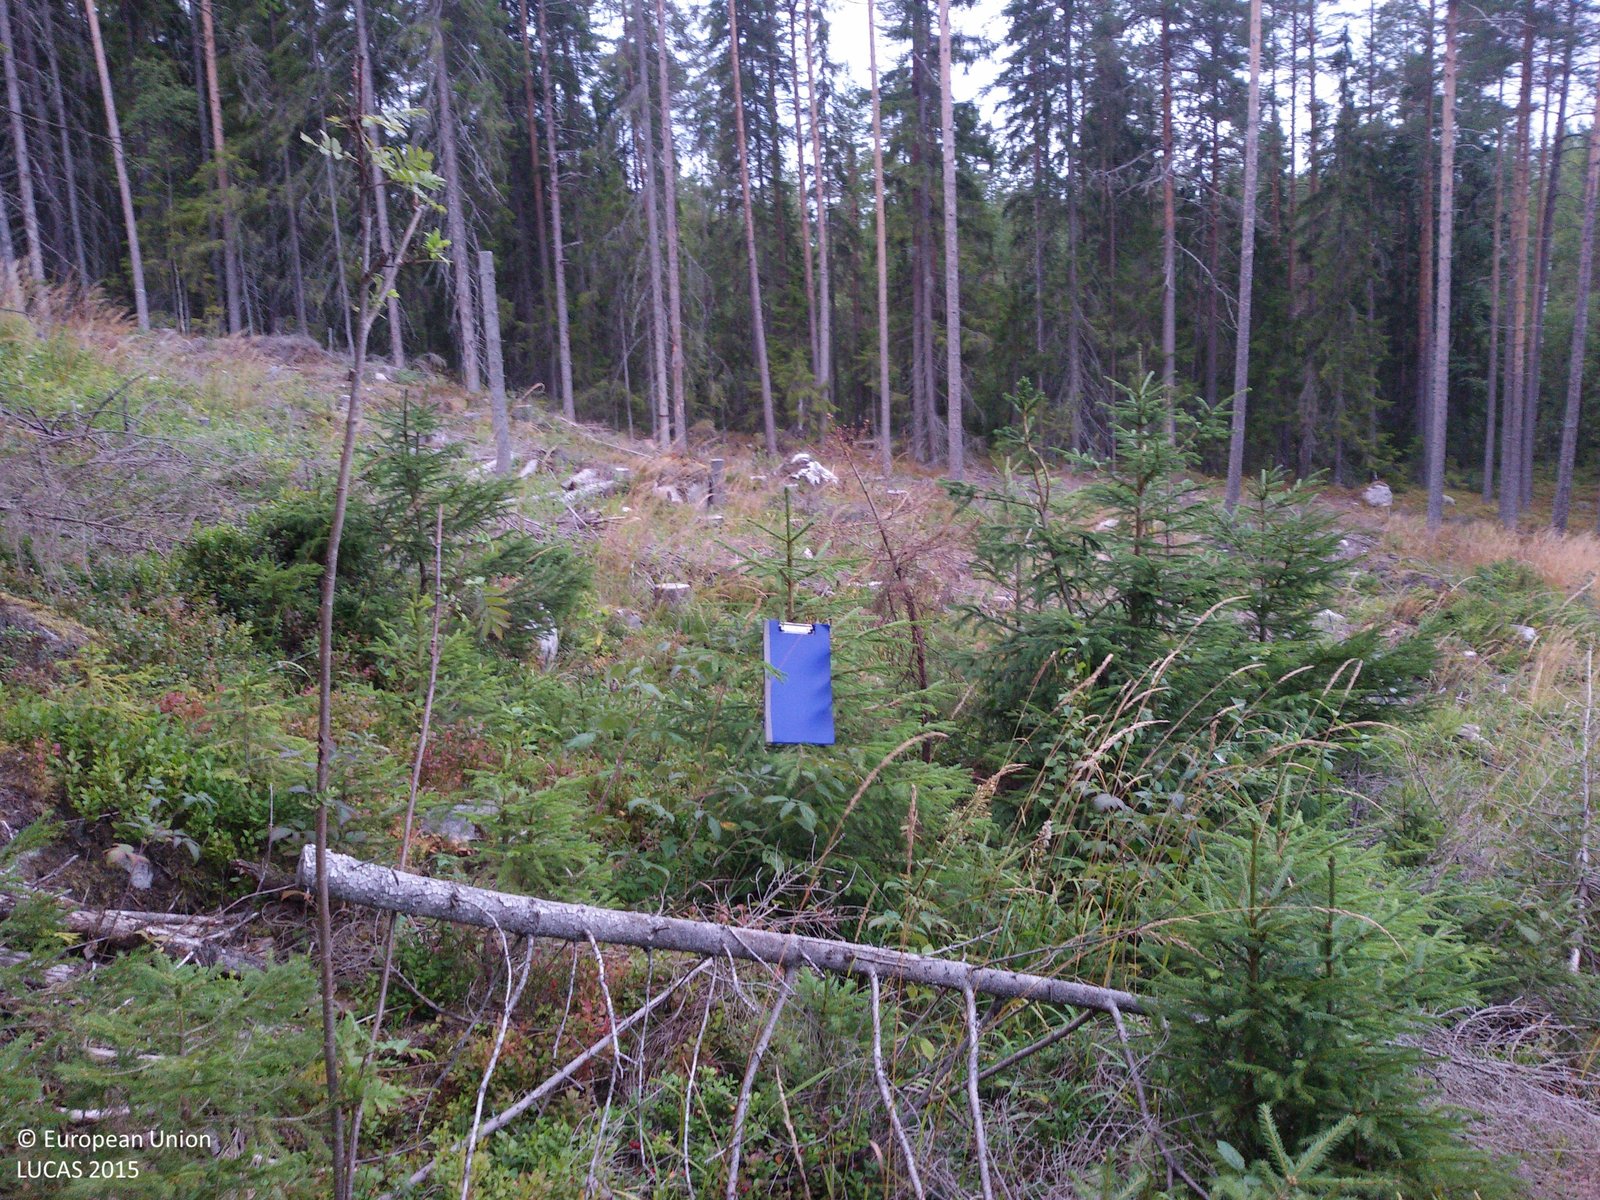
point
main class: Woodland
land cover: Spruce dominated coniferous woodland
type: boreal forest
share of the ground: 10 - 25 %
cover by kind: herbaceous plants 70 %, coniferous forest trees 20 %
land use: Forestry
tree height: > 5 m
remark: Nursery
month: September
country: SE
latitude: 60.9327
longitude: 15.6877
